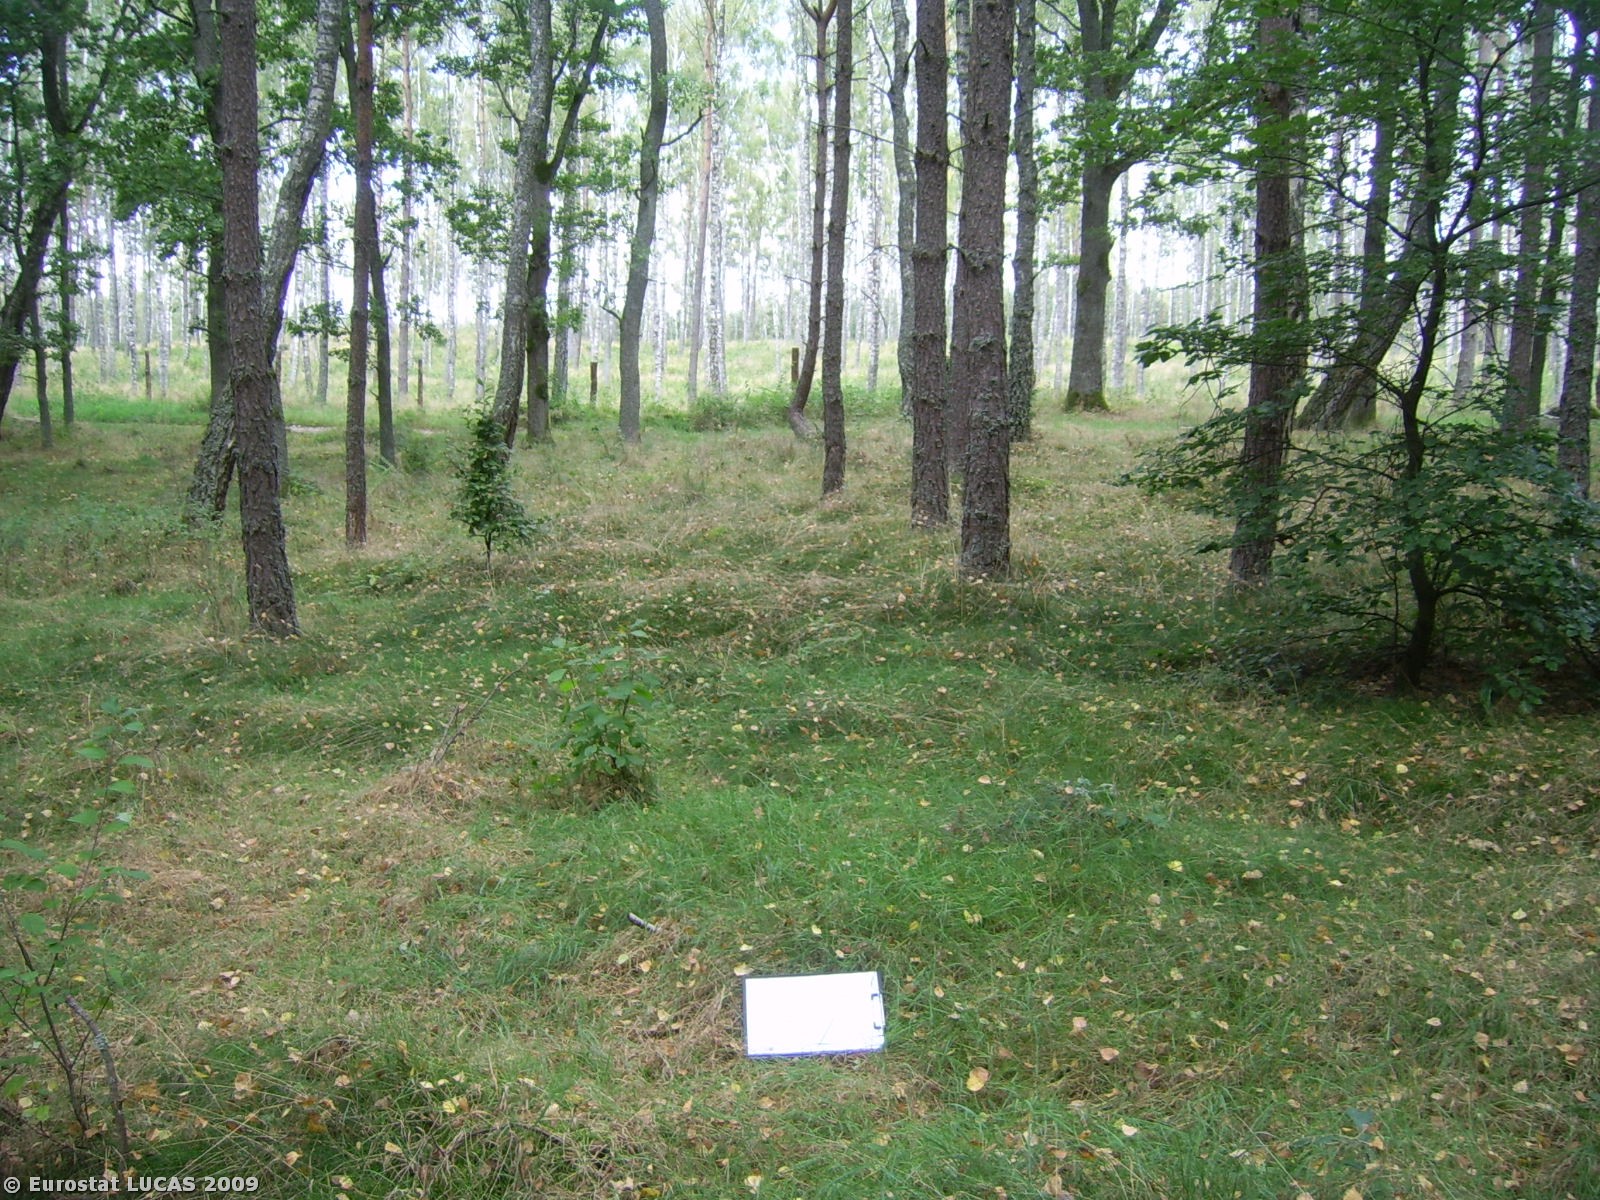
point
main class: Woodland
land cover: Mixed woodland
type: hemiboreal forest and nemoral coniferous forest and mixed broadleaved-coniferous forest
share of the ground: 50 - 75 %
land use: Unused
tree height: > 5 m
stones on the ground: < 10 %
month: September
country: PL
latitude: 53.6682
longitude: 16.3478
